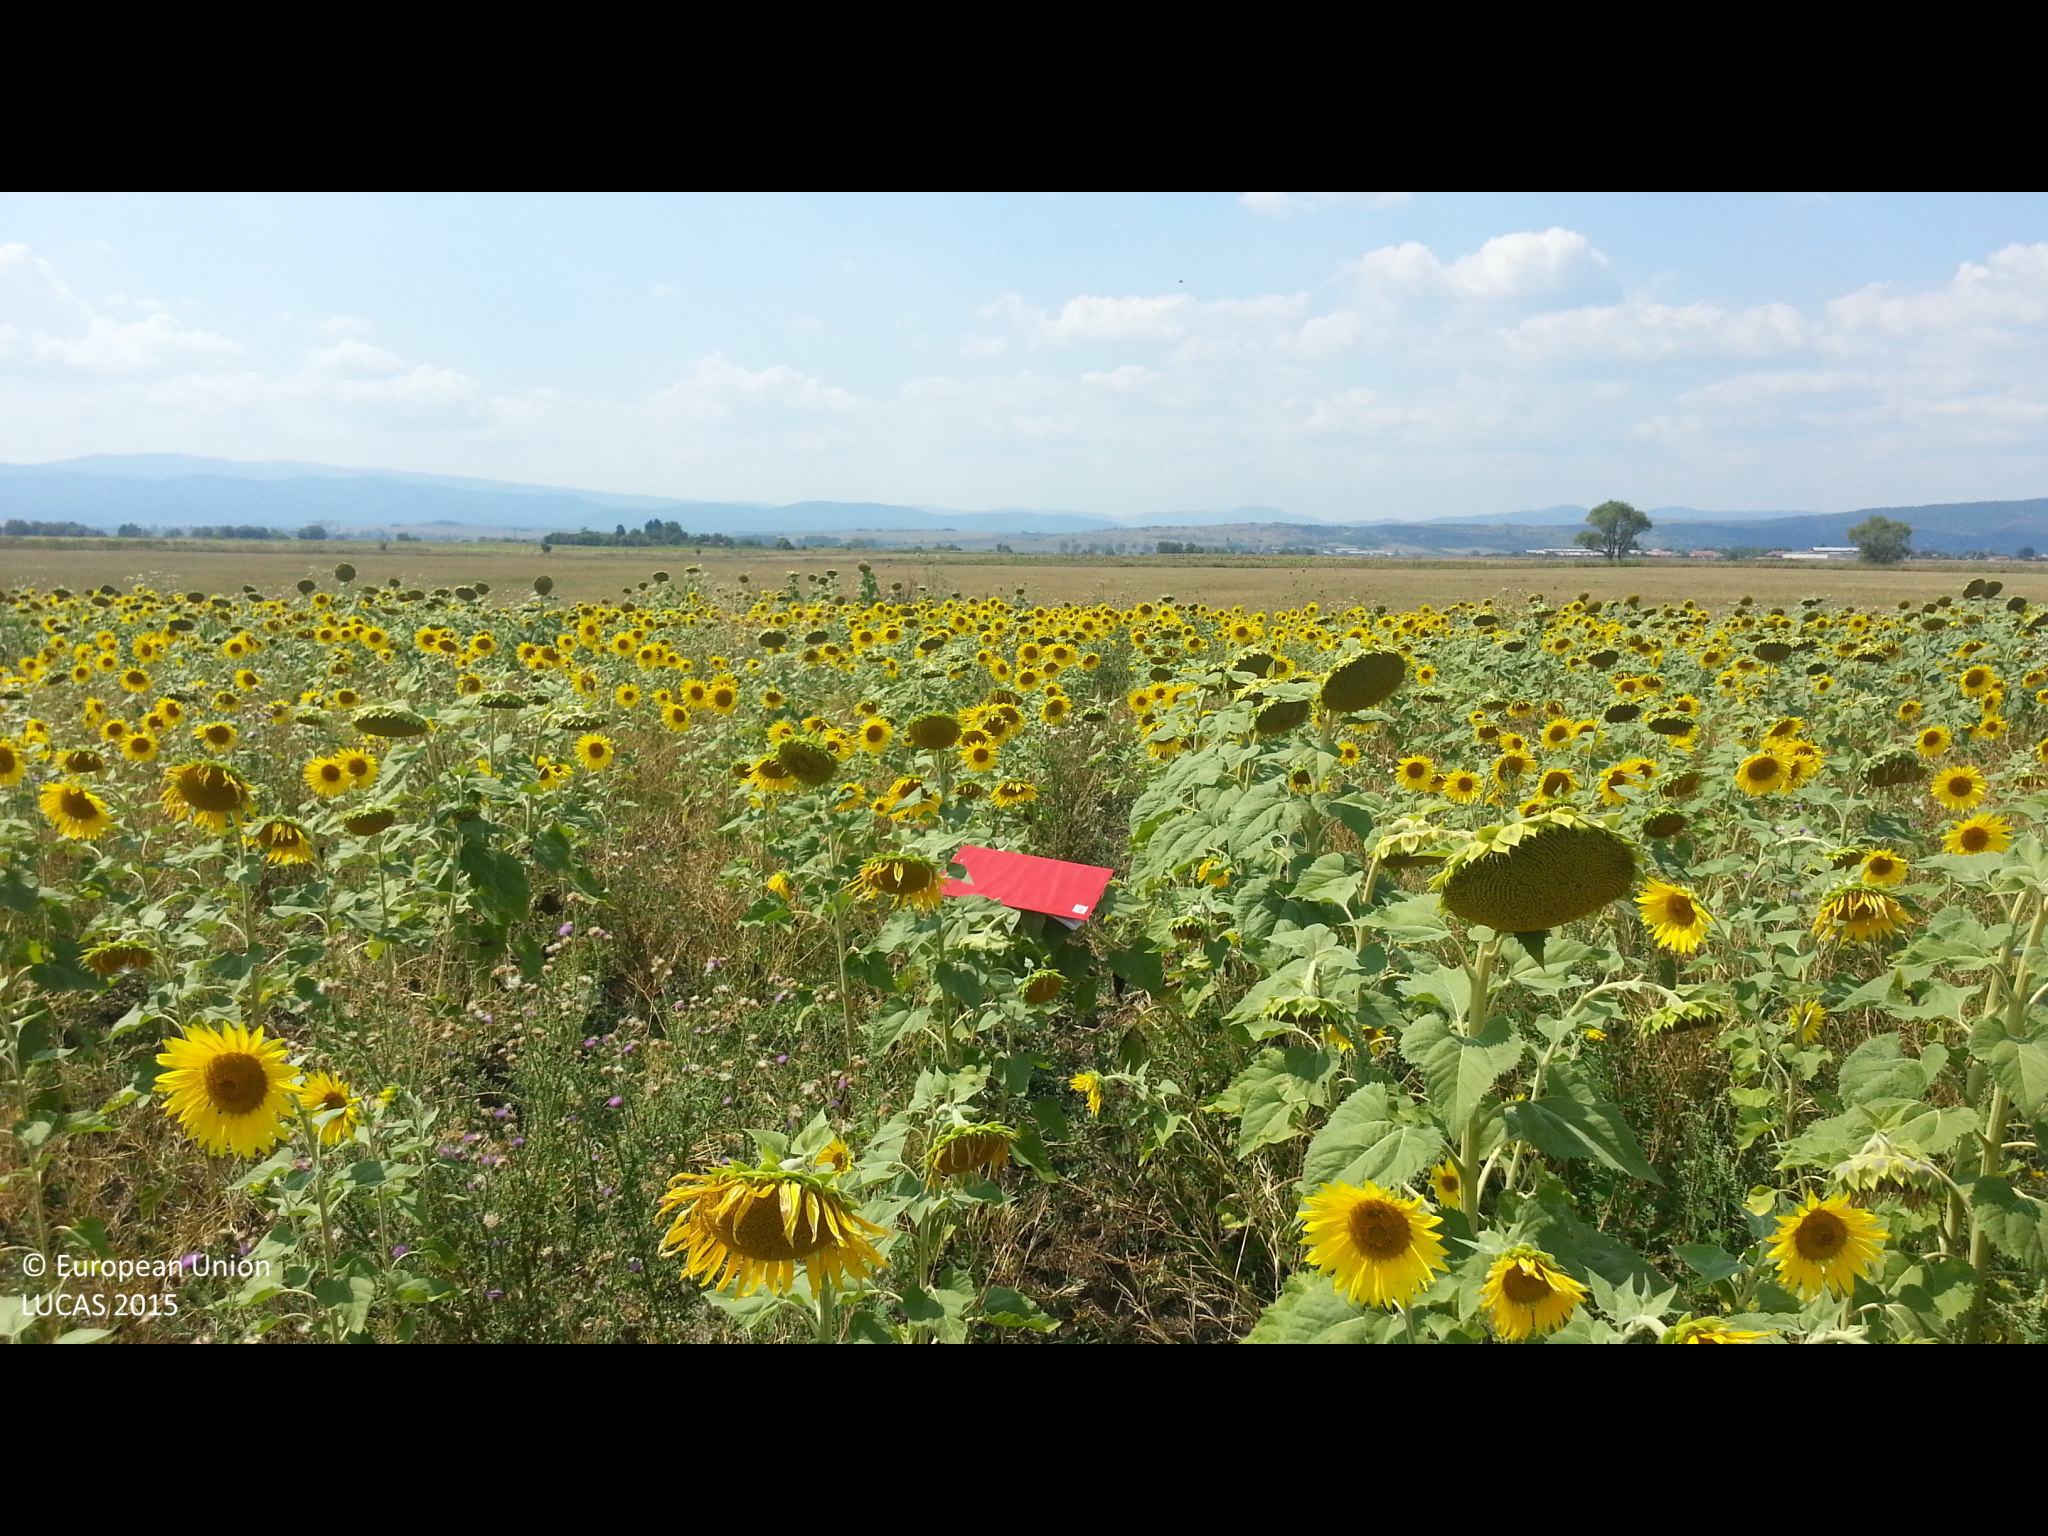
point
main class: Cropland
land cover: Sunflower
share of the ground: 50 - 75 %
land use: Agriculture (excluding fallow land and kitchen gardens)
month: August
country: BG
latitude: 42.4755
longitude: 22.9571
